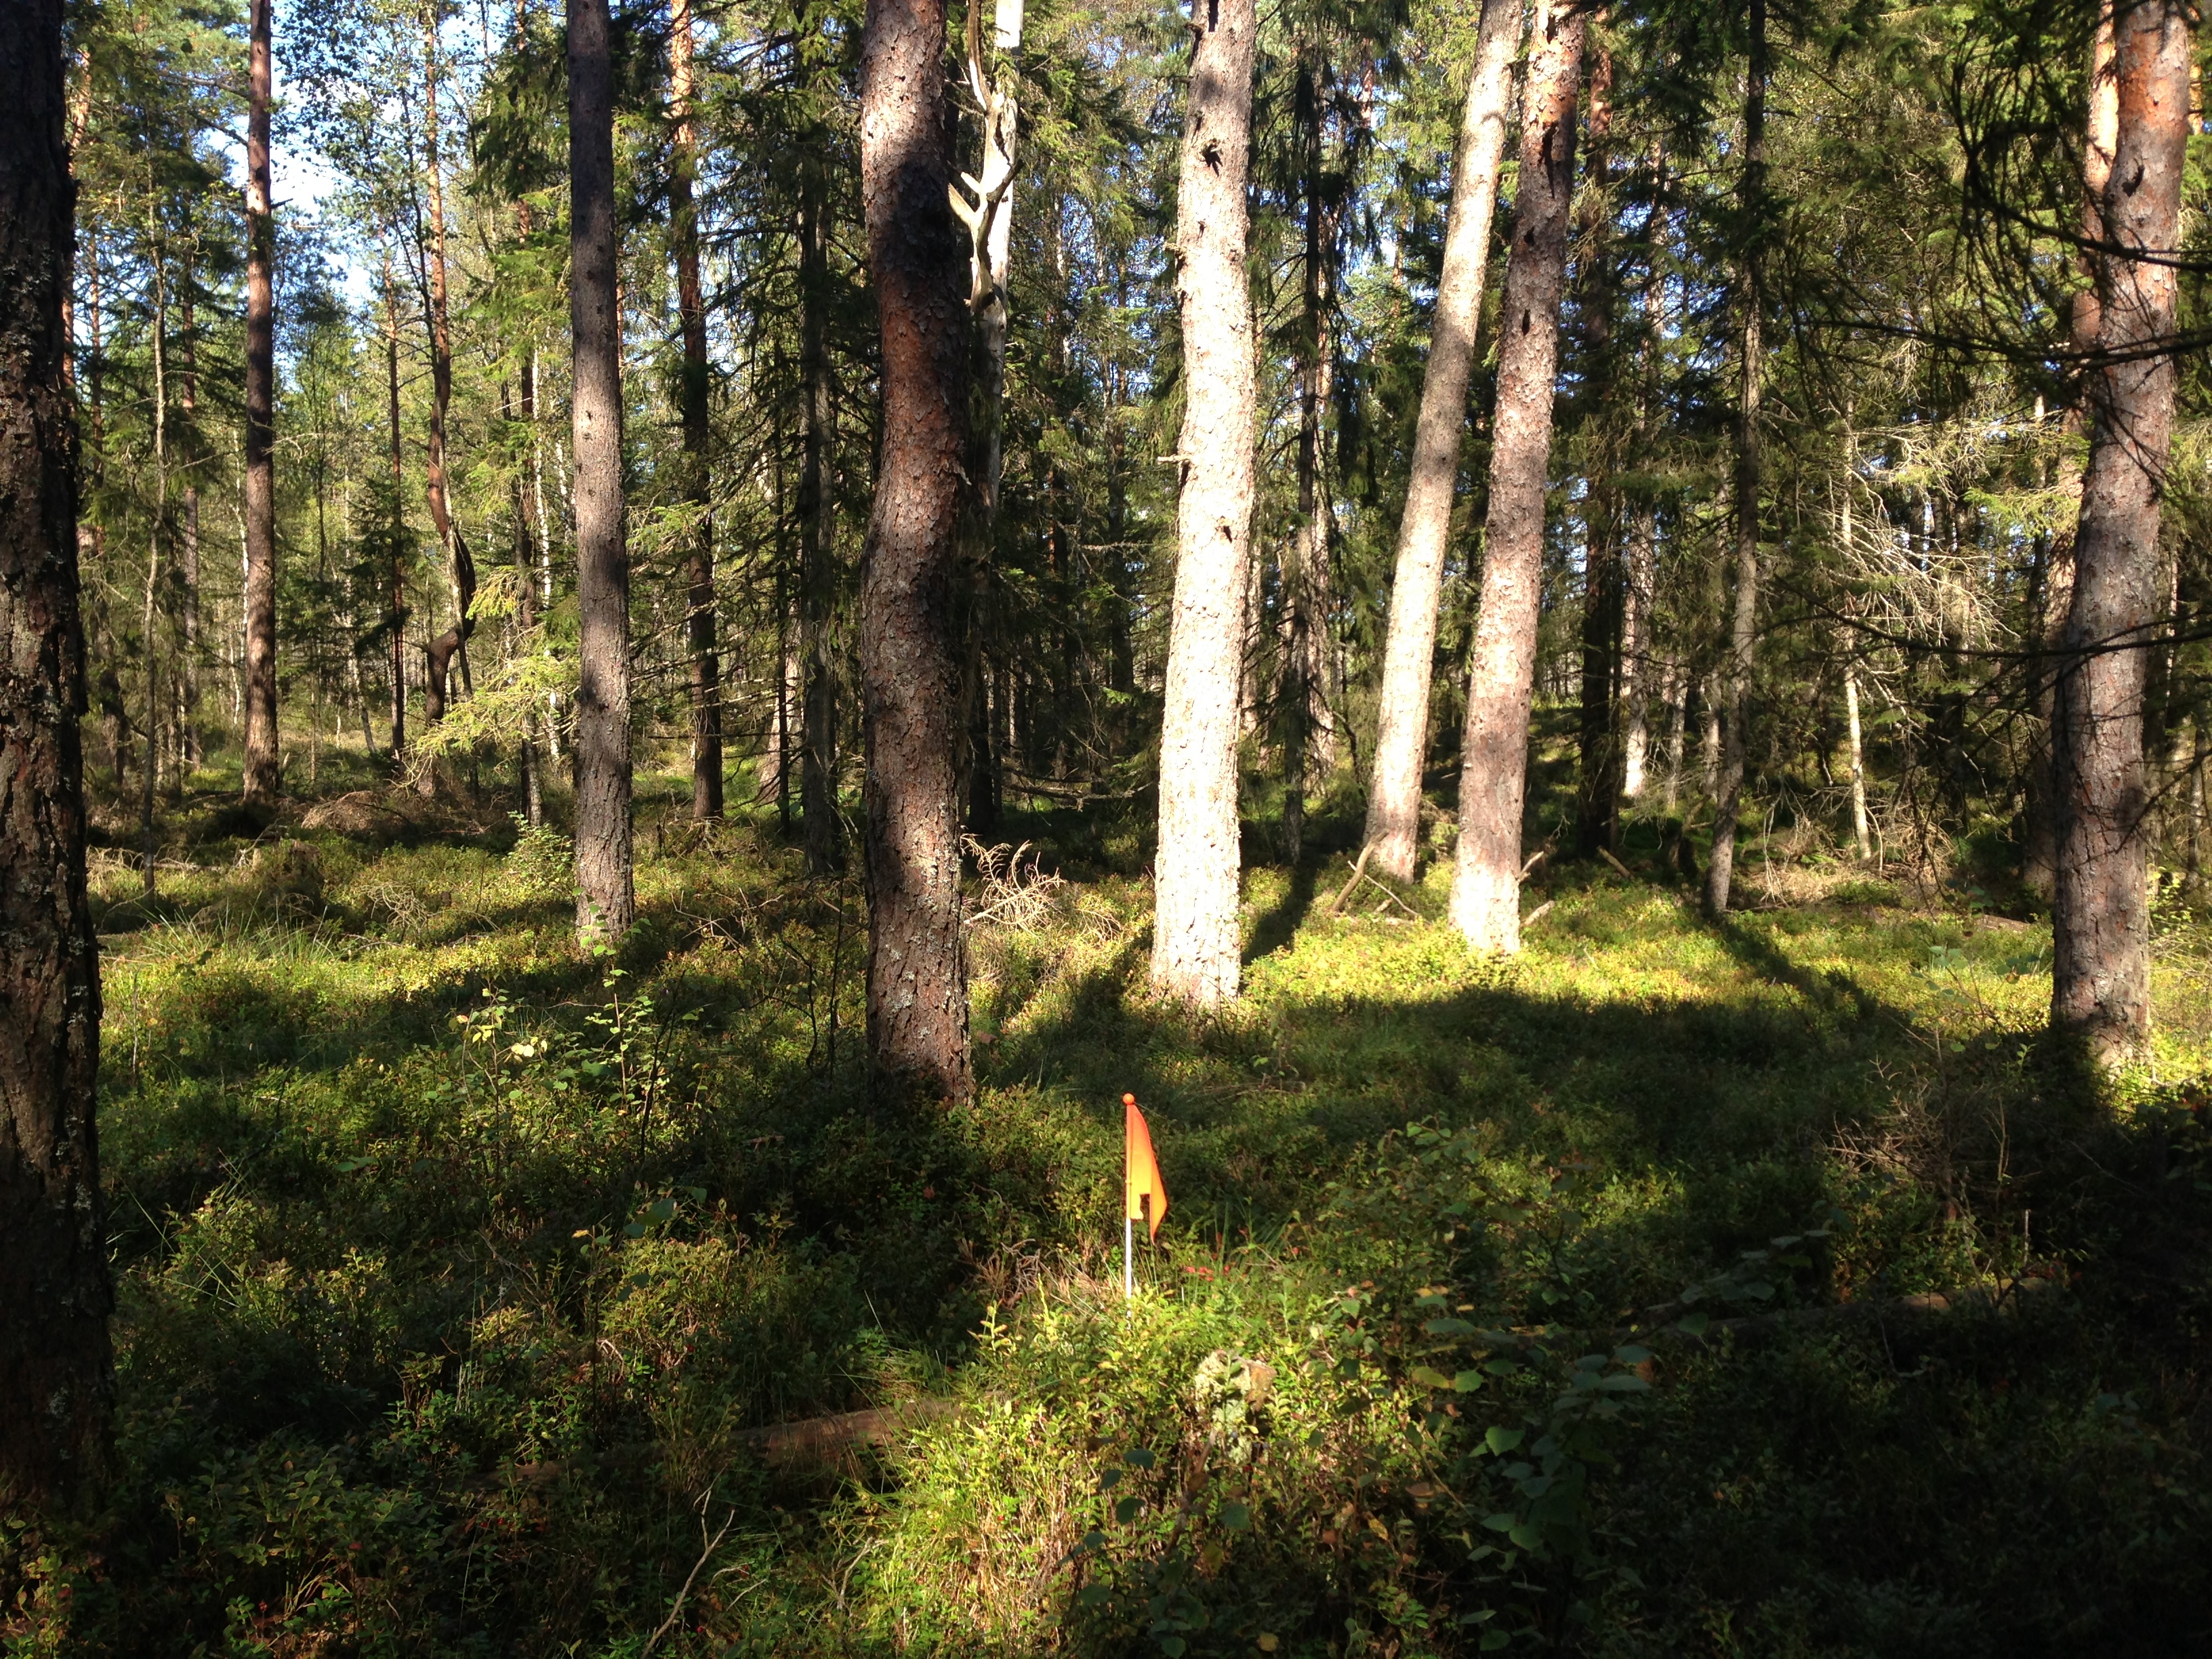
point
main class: Woodland
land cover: Pine dominated coniferous woodland
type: boreal forest
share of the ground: 50 - 75 %
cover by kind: coniferous forest trees 75 %, shrubs 25 %
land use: Forestry
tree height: > 5 m
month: September
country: SE
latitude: 57.1722
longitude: 13.2543
